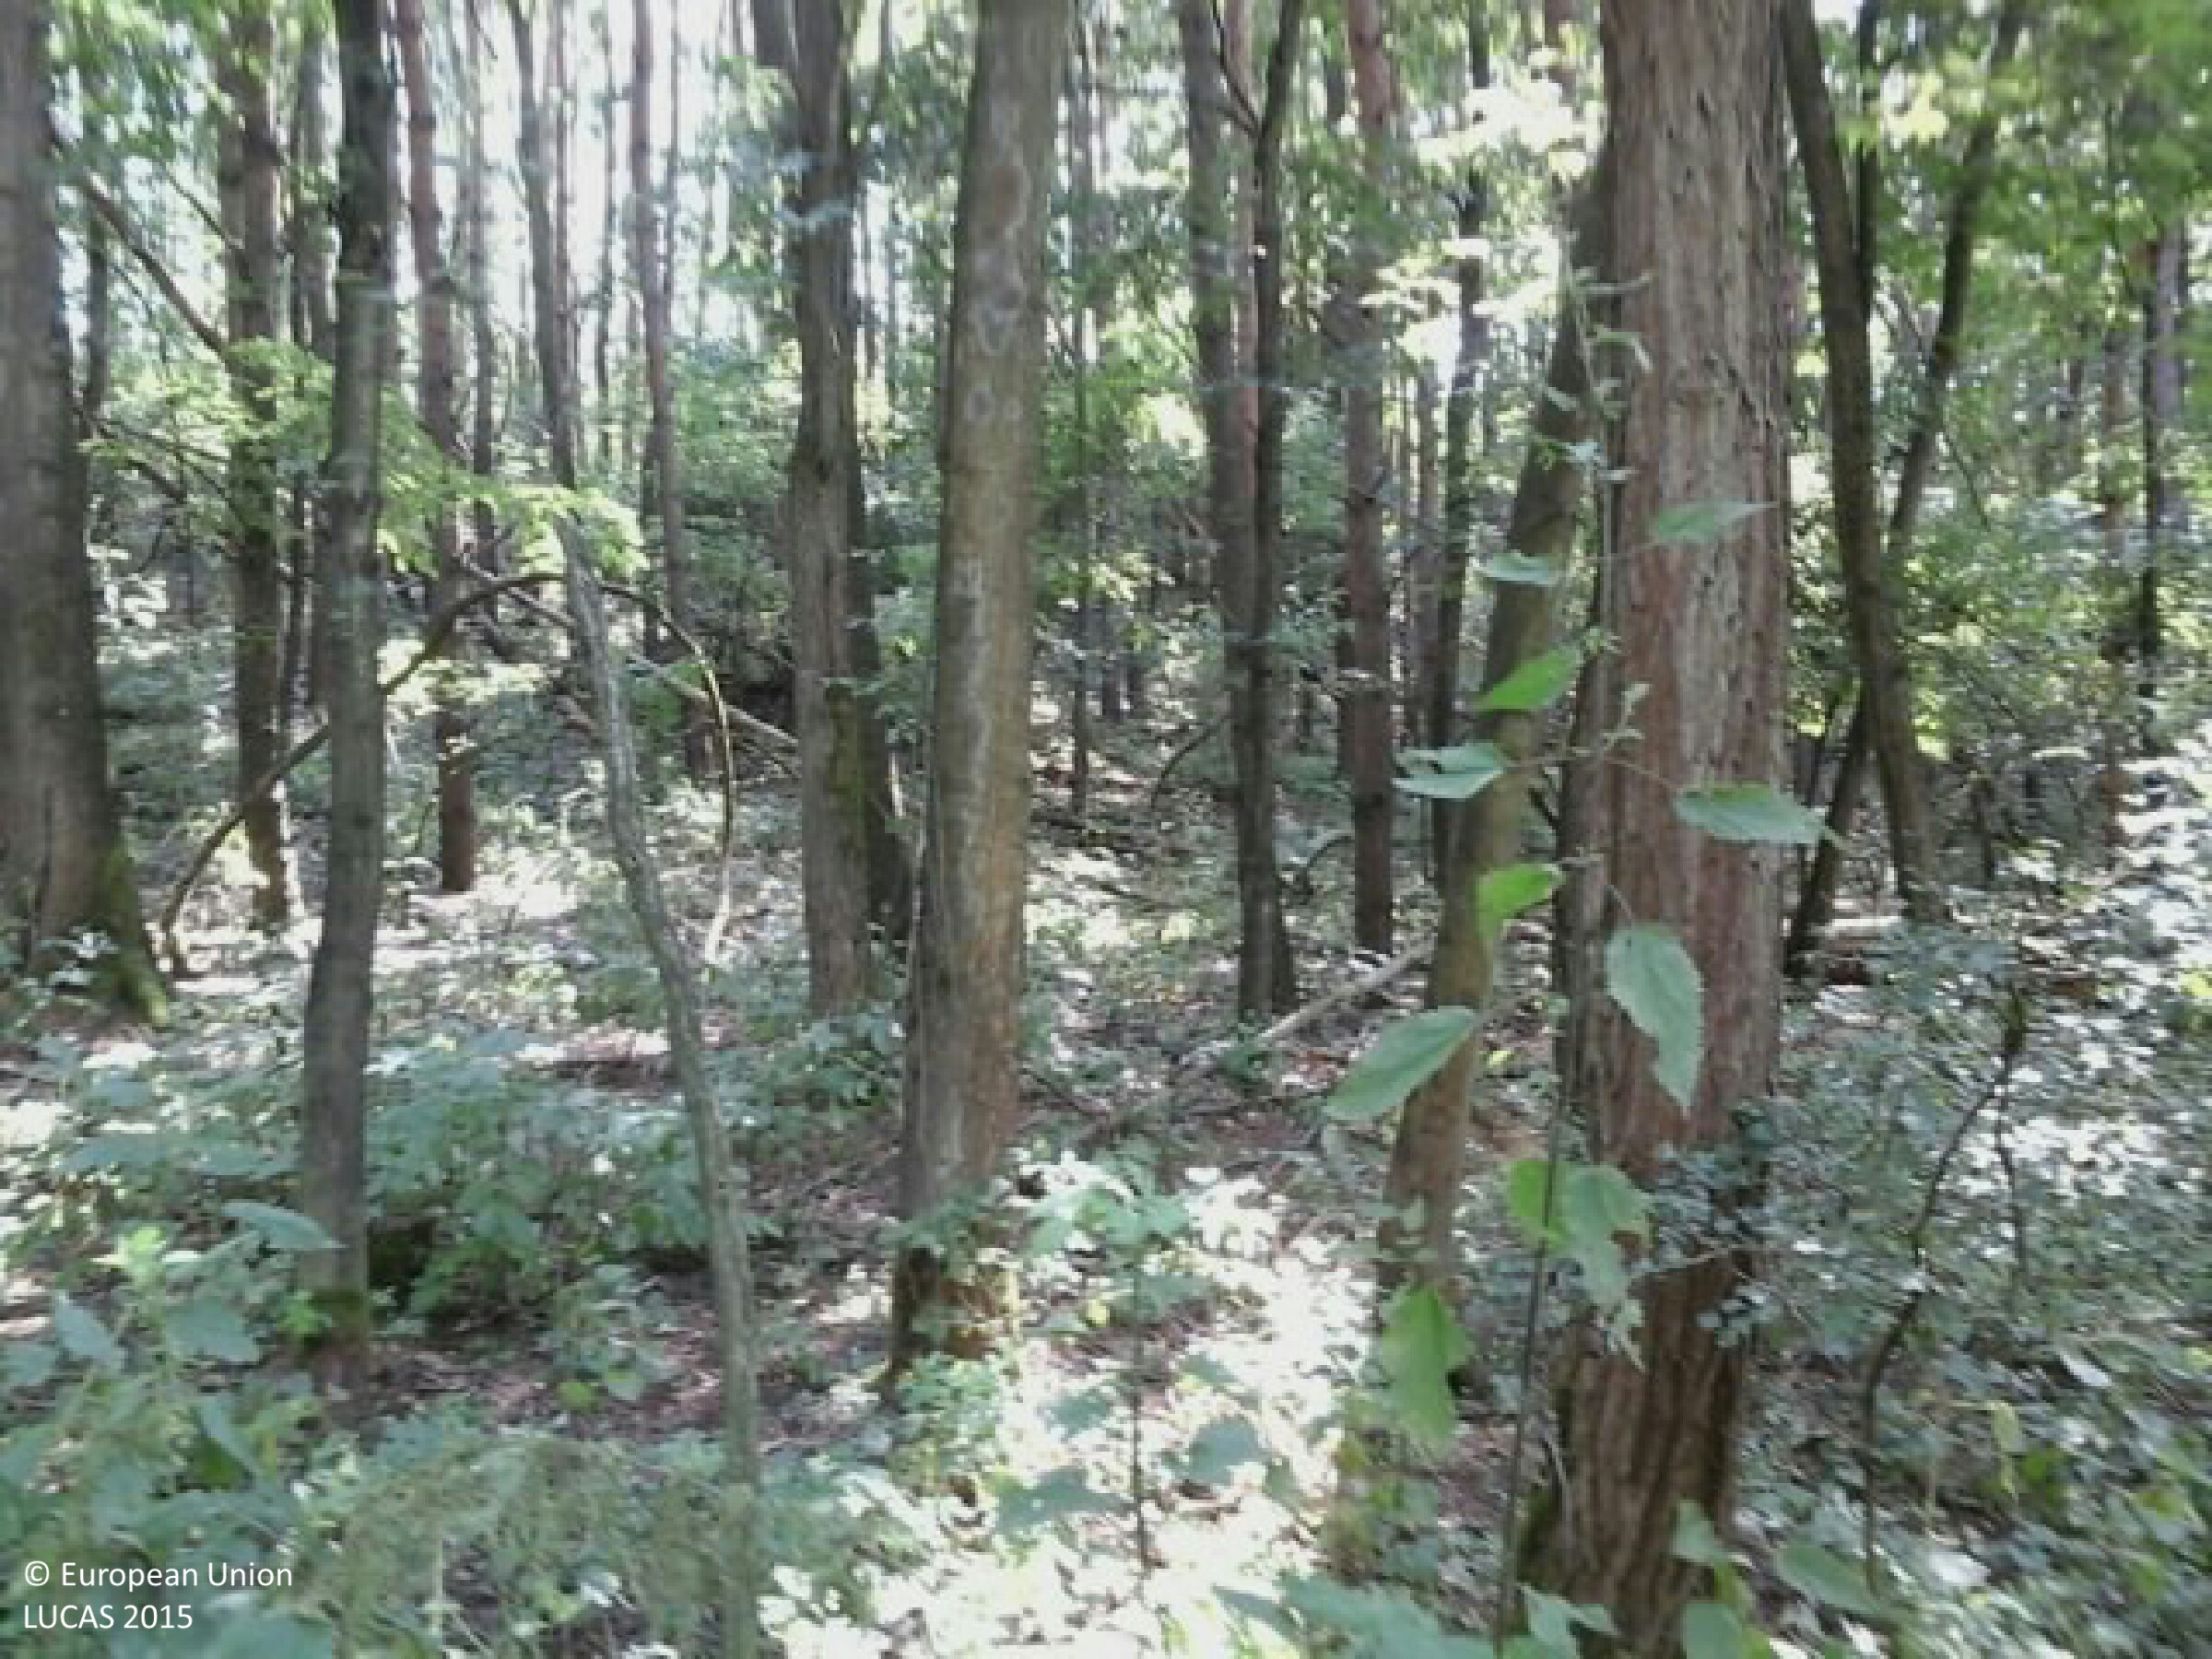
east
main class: Woodland
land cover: Broadleaved woodland
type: mesophytic deciduous forest
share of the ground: > 75 %
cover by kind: broadleaved forest trees 90 %, herbaceous plants 10 %
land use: Forestry
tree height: > 5 m
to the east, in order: Broadleaved woodland; Grassland with sparse tree/shrub cover
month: August
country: HU
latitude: 48.0046
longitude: 19.9869
